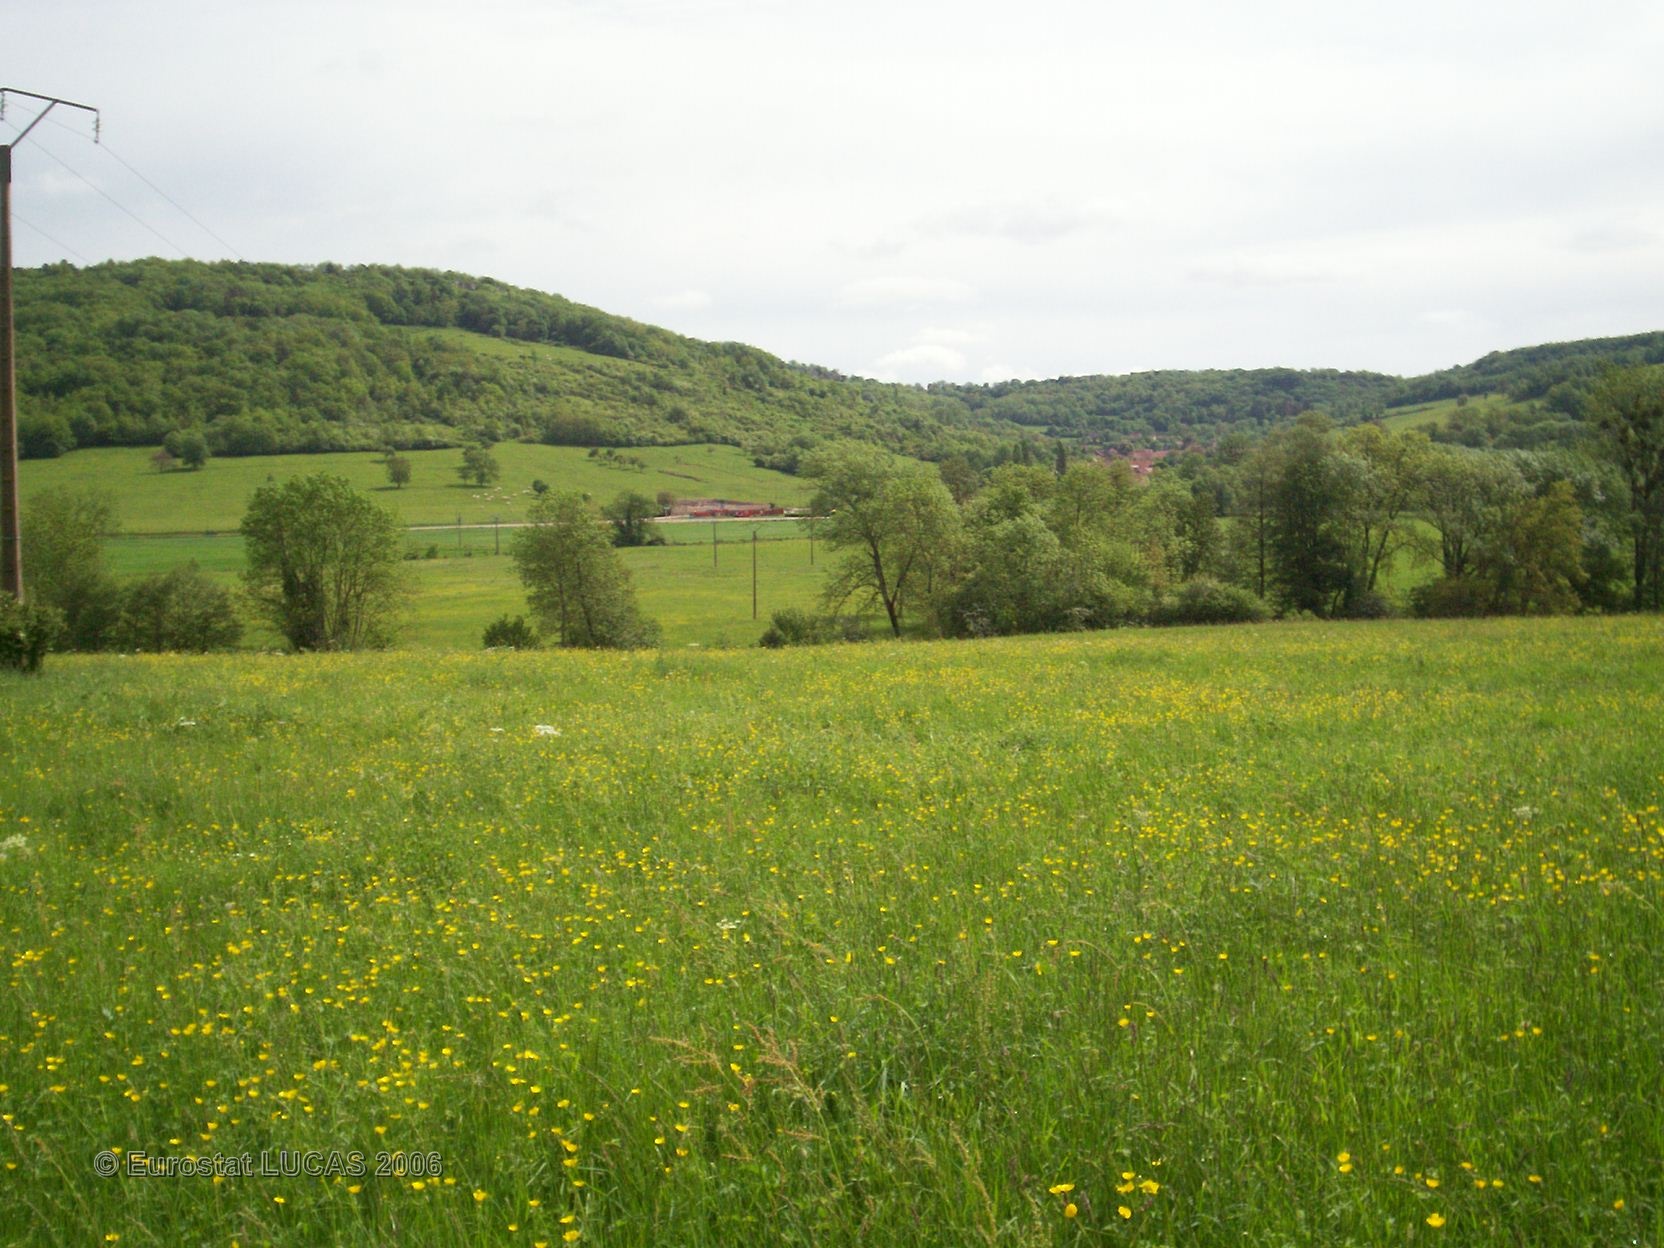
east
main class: Grassland
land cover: Grassland without tree/shrub cover
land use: Agriculture (excluding fallow land and kitchen gardens)
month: May
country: FR
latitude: 47.3676
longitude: 4.5570
